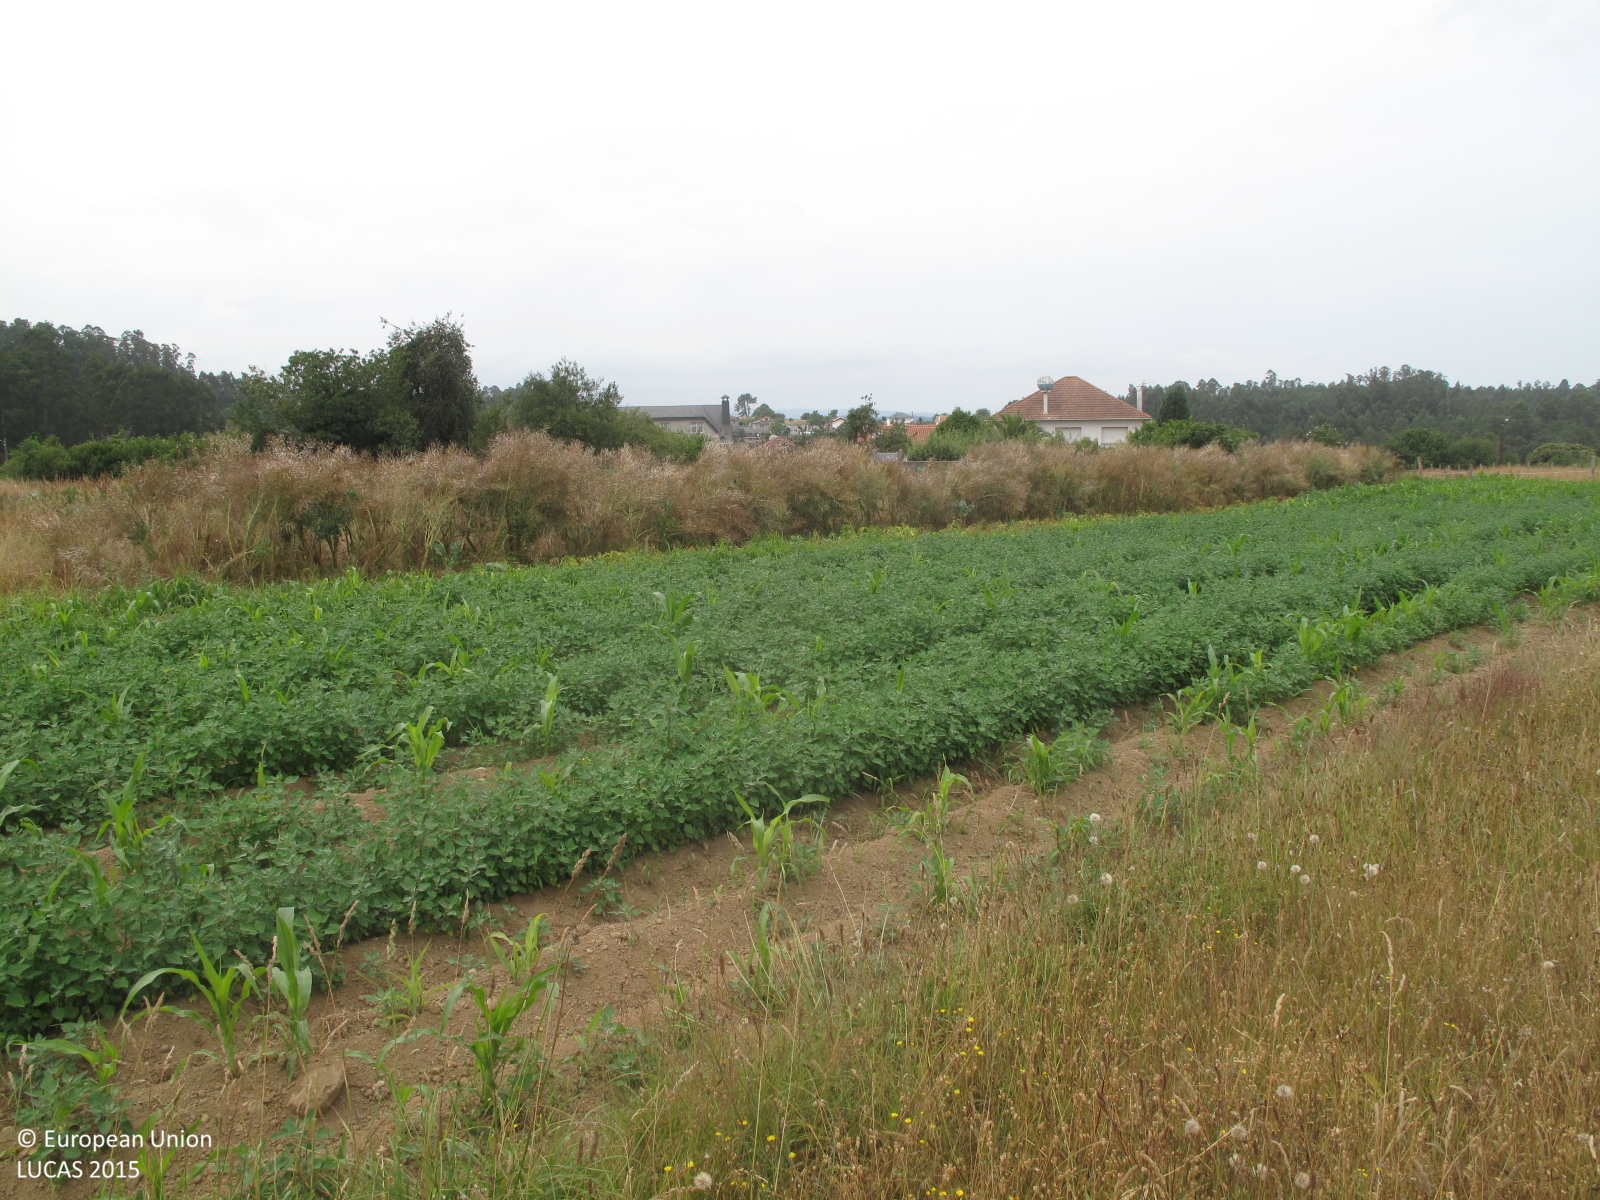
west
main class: Grassland
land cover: Spontaneously vegetated surfaces
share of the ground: > 75 %
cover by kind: herbaceous plants 100 %
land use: Abandoned areas
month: July
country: ES
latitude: 43.2559
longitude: -8.2194
